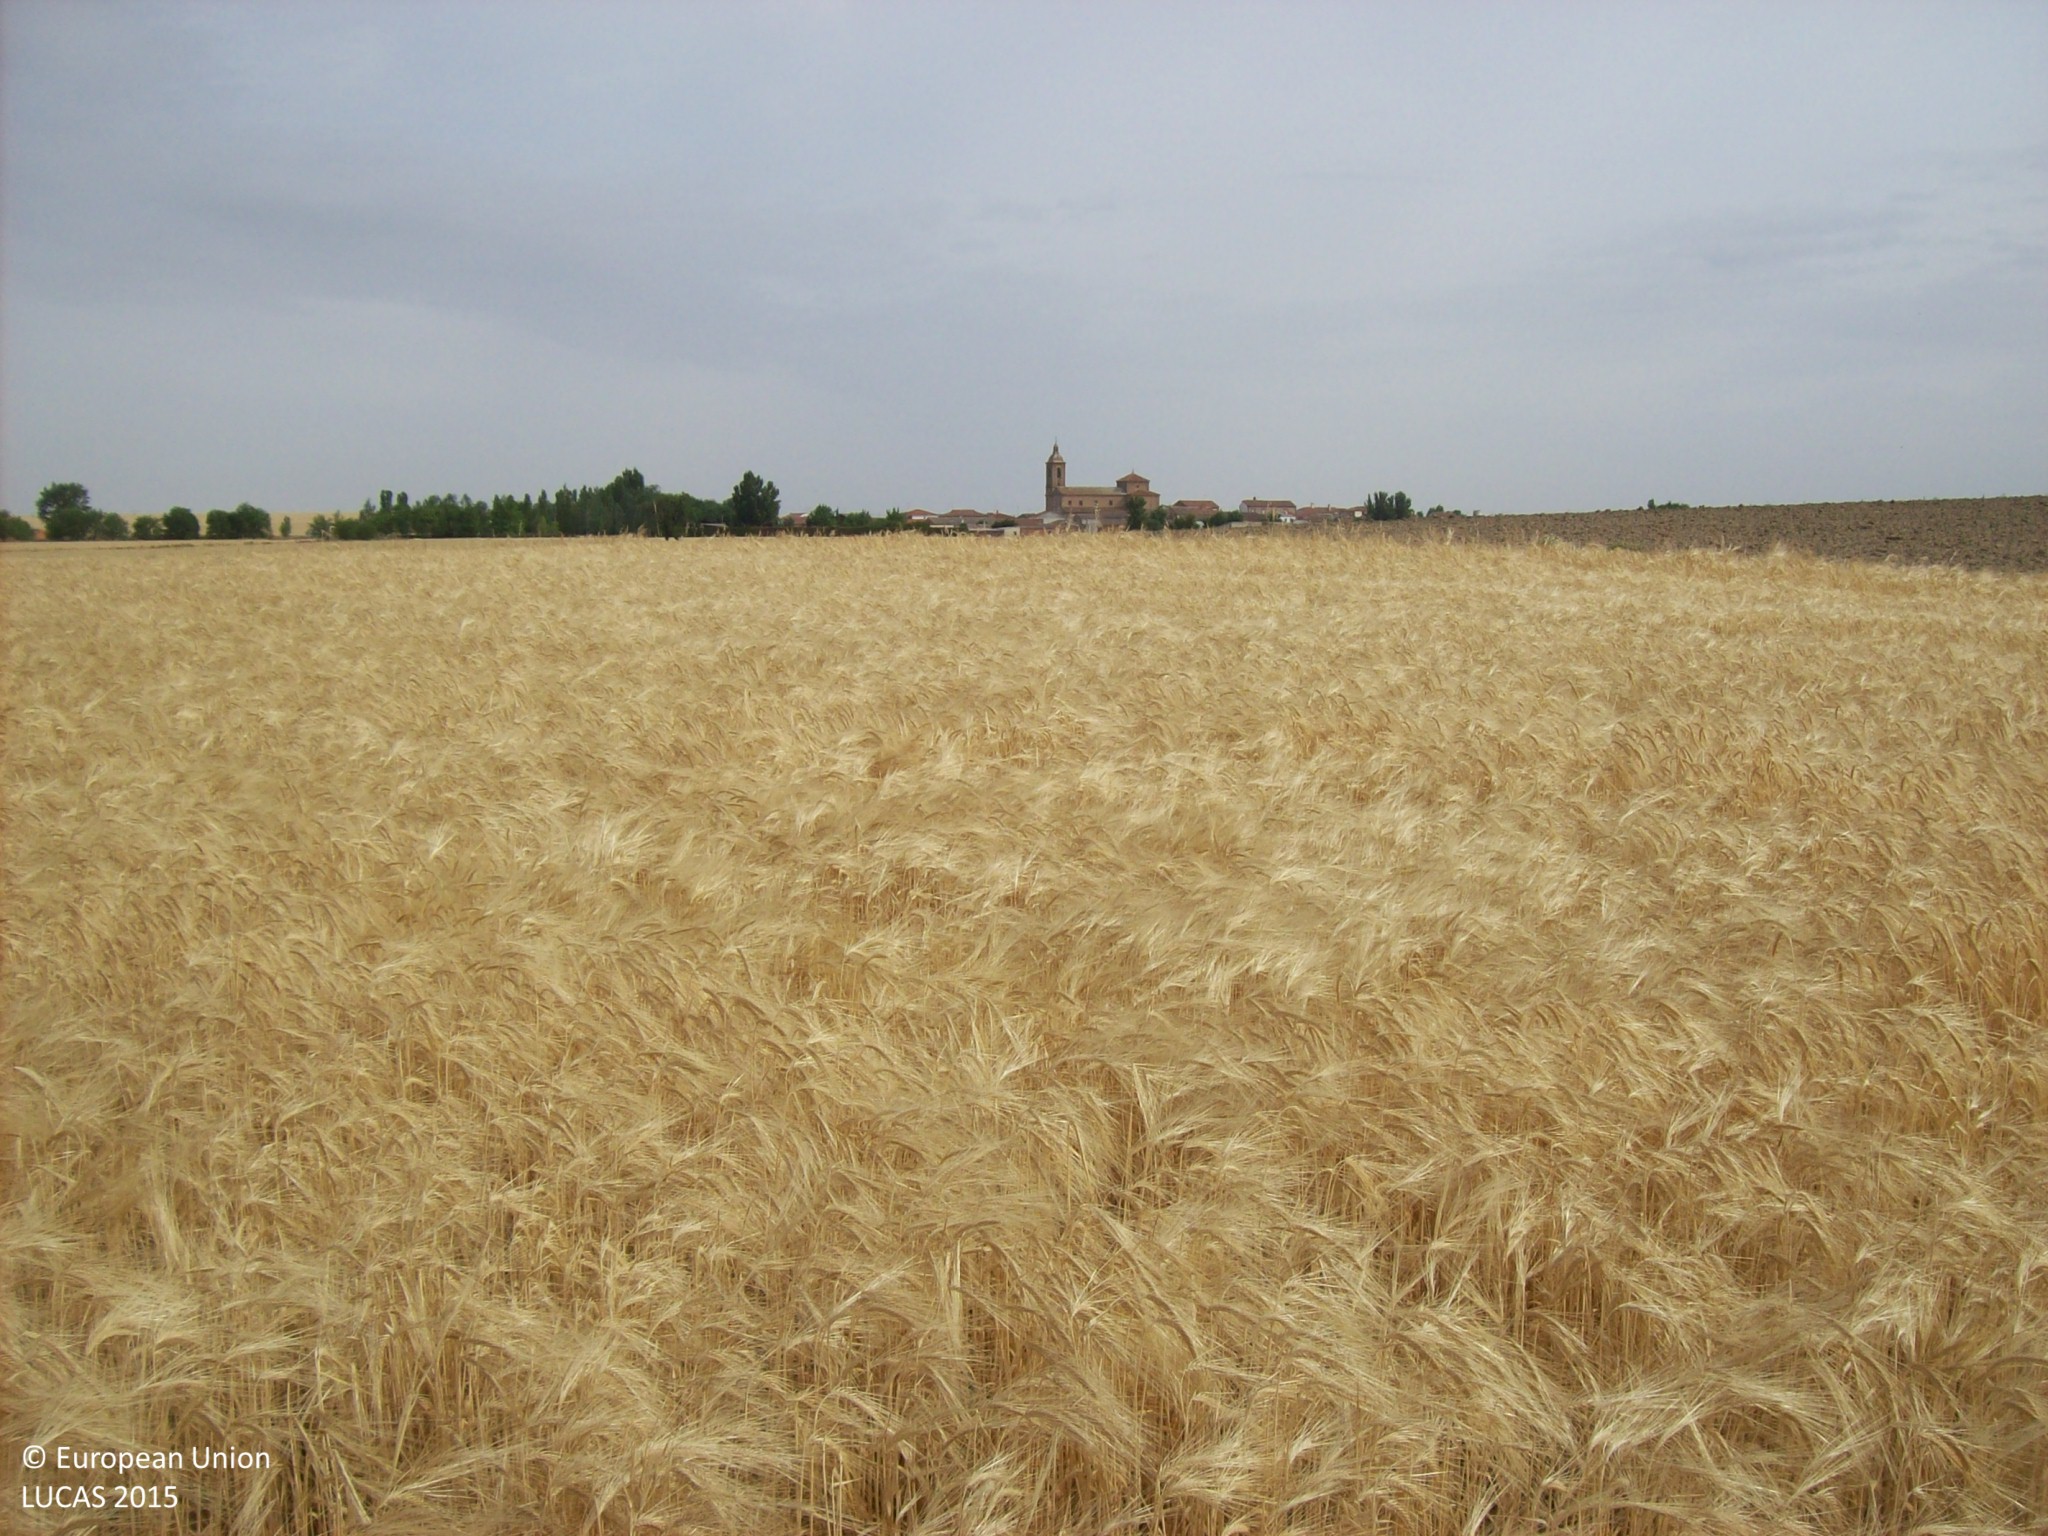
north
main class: Cropland
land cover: Barley
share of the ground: > 75 %
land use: Agriculture (excluding fallow land and kitchen gardens)
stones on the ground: < 10 %
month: June
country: ES
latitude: 41.0389
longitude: -4.9704
